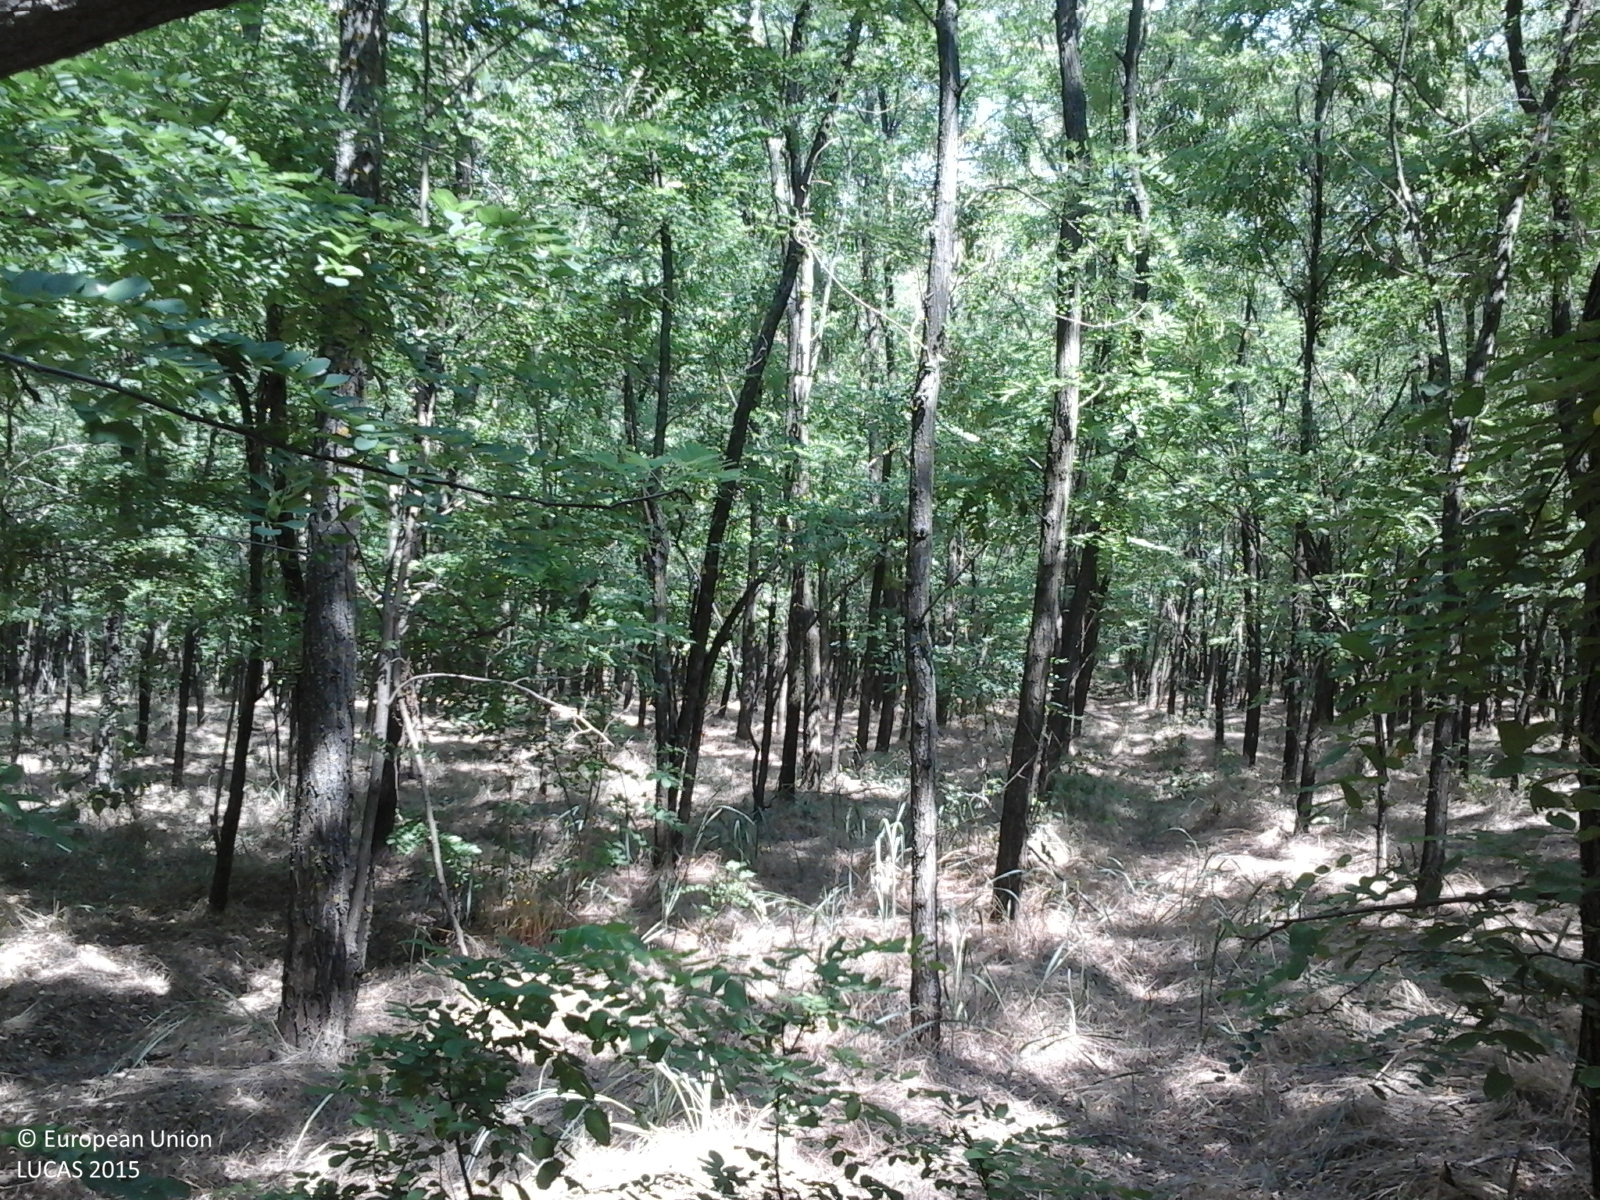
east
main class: Woodland
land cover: Broadleaved woodland
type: broadleaved evergreen forest
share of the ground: > 75 %
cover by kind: broadleaved forest trees 90 %, herbaceous plants 10 %
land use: Forestry
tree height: > 5 m
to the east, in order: Broadleaved woodland; Tracks; Broadleaved woodland
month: July
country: RO
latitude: 44.9159
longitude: 27.1497
